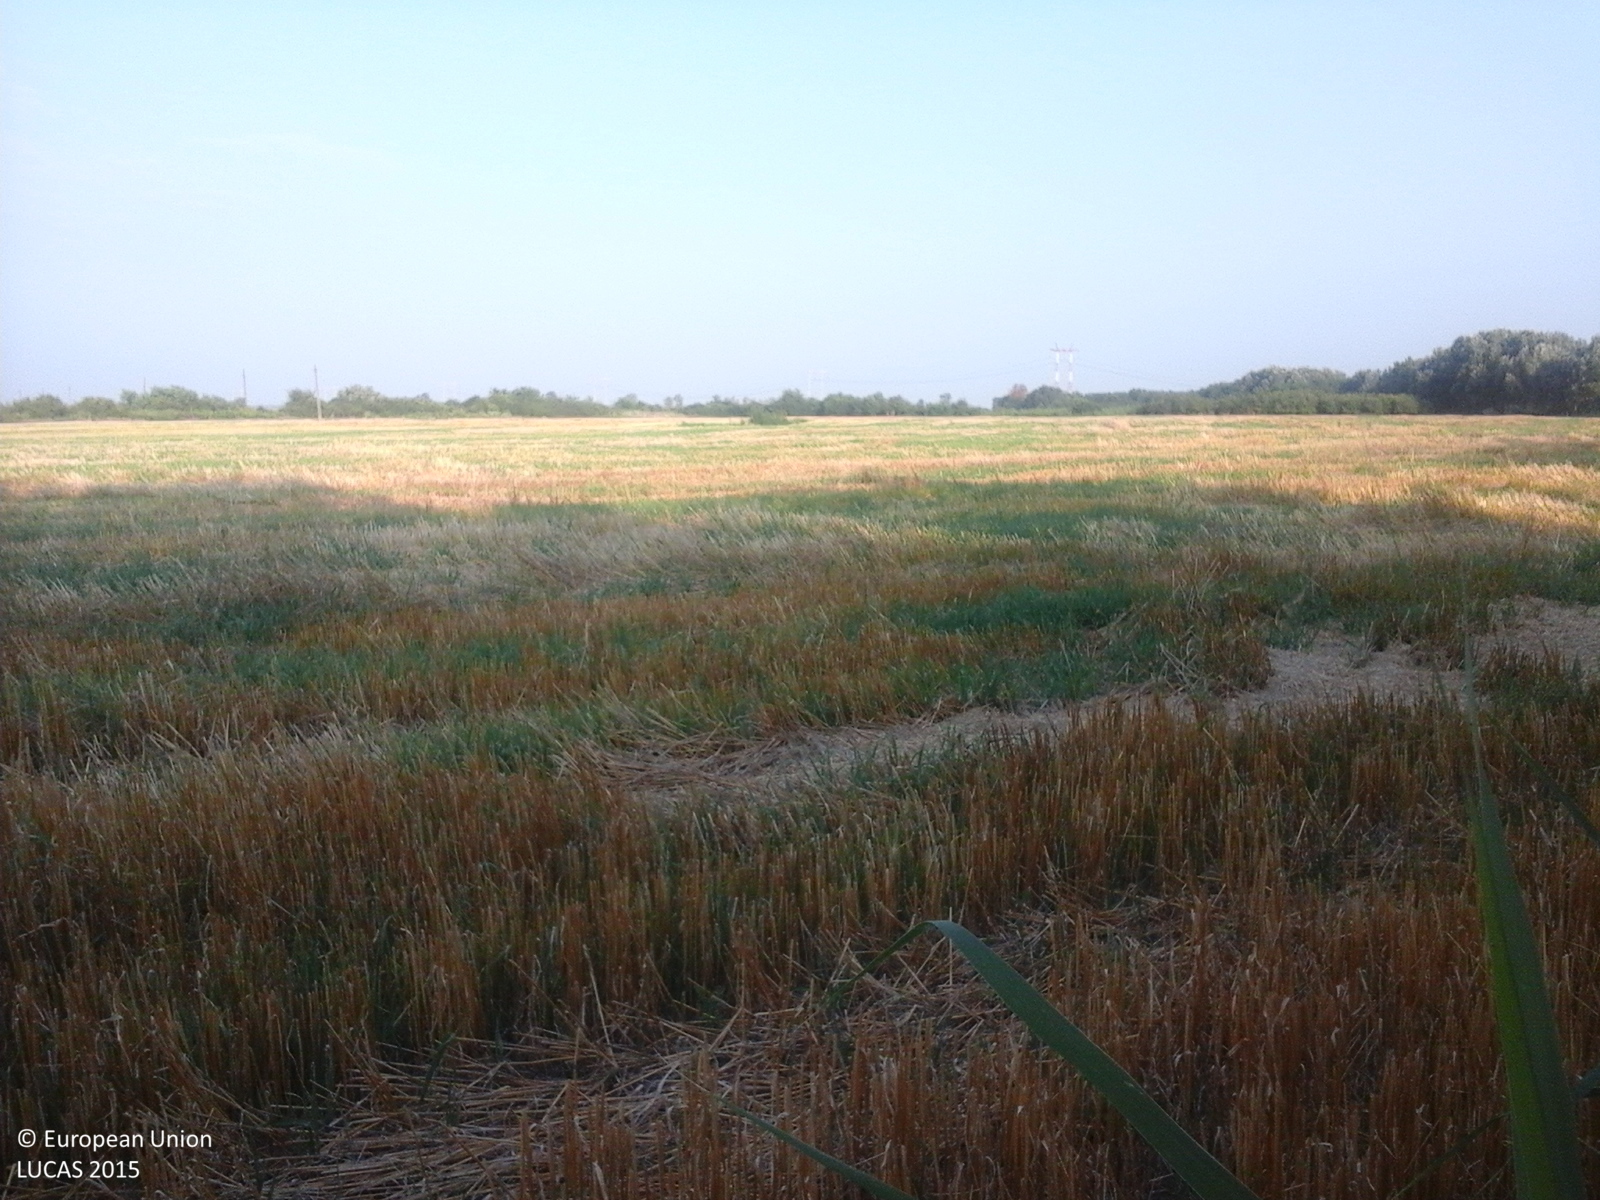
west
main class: Woodland
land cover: Broadleaved woodland
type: floodplain forest
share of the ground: > 75 %
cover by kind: broadleaved forest trees 100 %
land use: Forestry
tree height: > 5 m
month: July
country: RO
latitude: 44.5795
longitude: 27.0707
